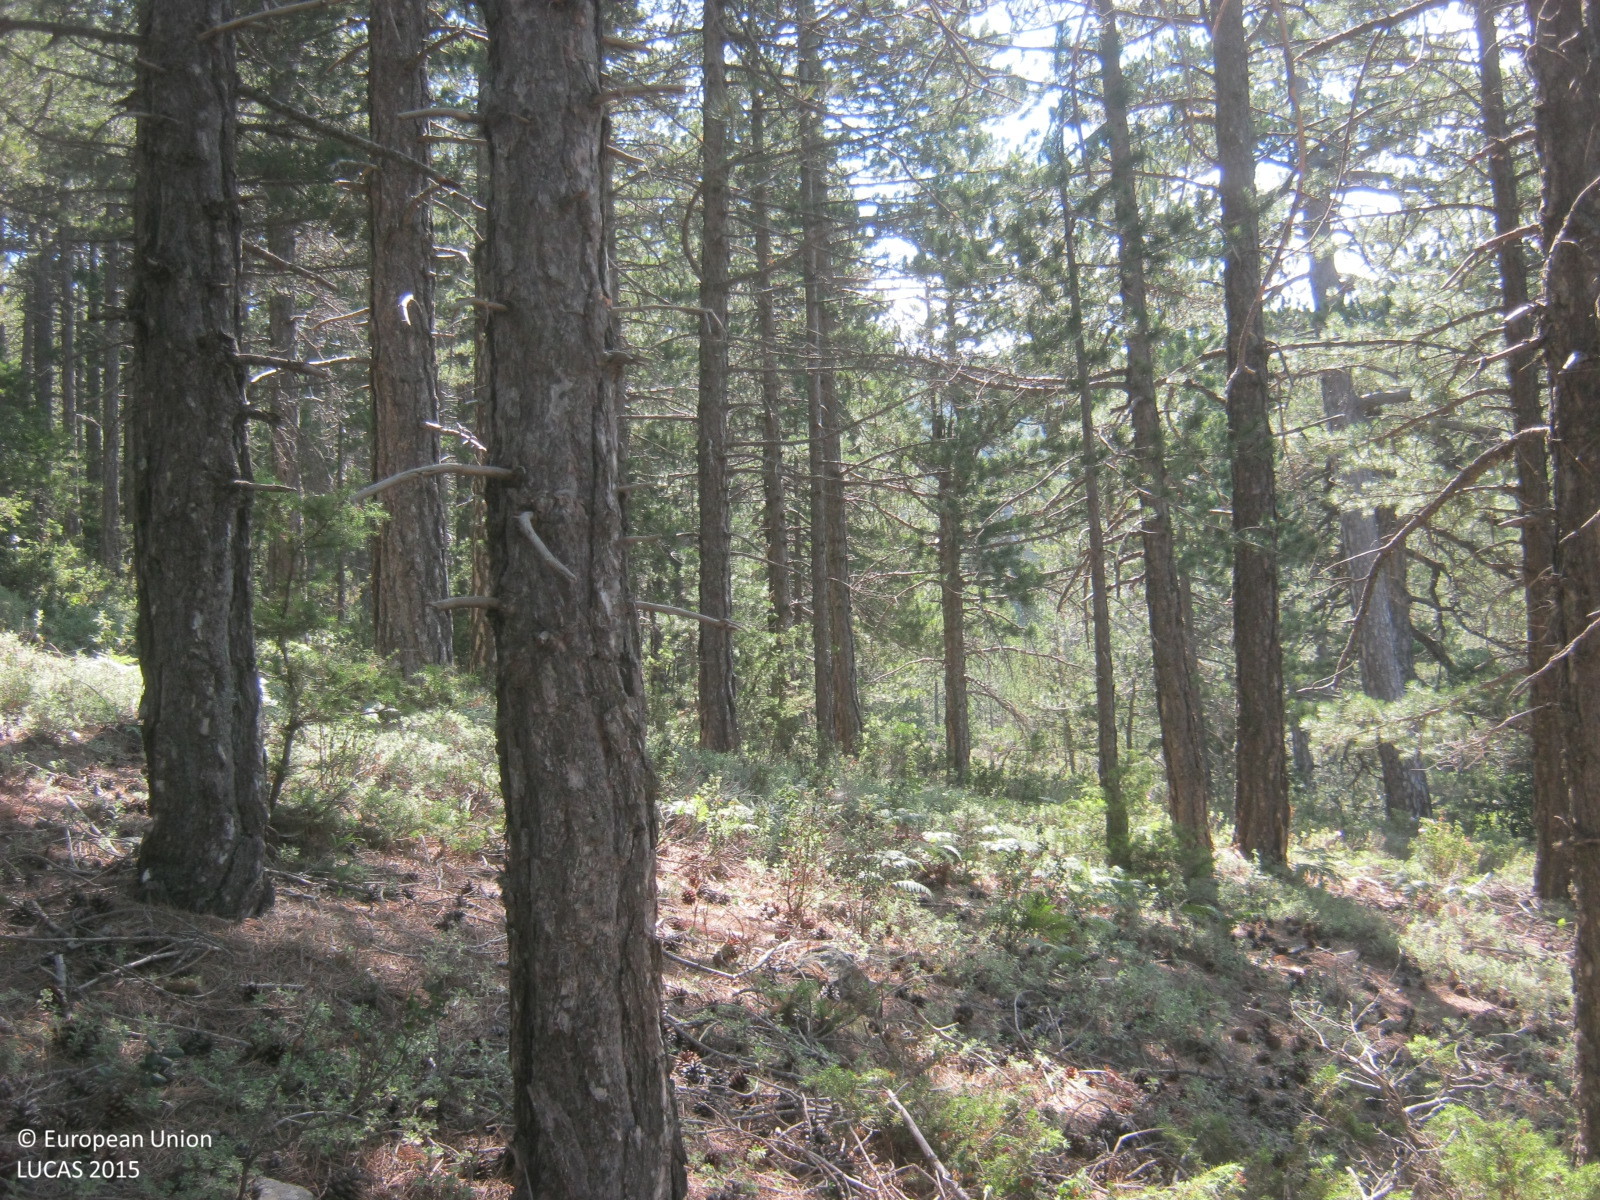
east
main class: Woodland
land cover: Pine dominated coniferous woodland
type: coniferous forest of the mediterranean region
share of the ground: > 75 %
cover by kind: coniferous forest trees 80 %, shrubs 10 %, broadleaved forest trees 5 %, unconsolidated bare surface 5 %
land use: Forestry
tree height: > 5 m
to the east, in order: Pine dominated coniferous woodland; Electric lines; Pine dominated coniferous woodland; Tracks; Pine dominated coniferous woodland; Tracks; Pine dominated coniferous woodland
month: June
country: CY
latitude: 34.9465
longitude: 32.8427
